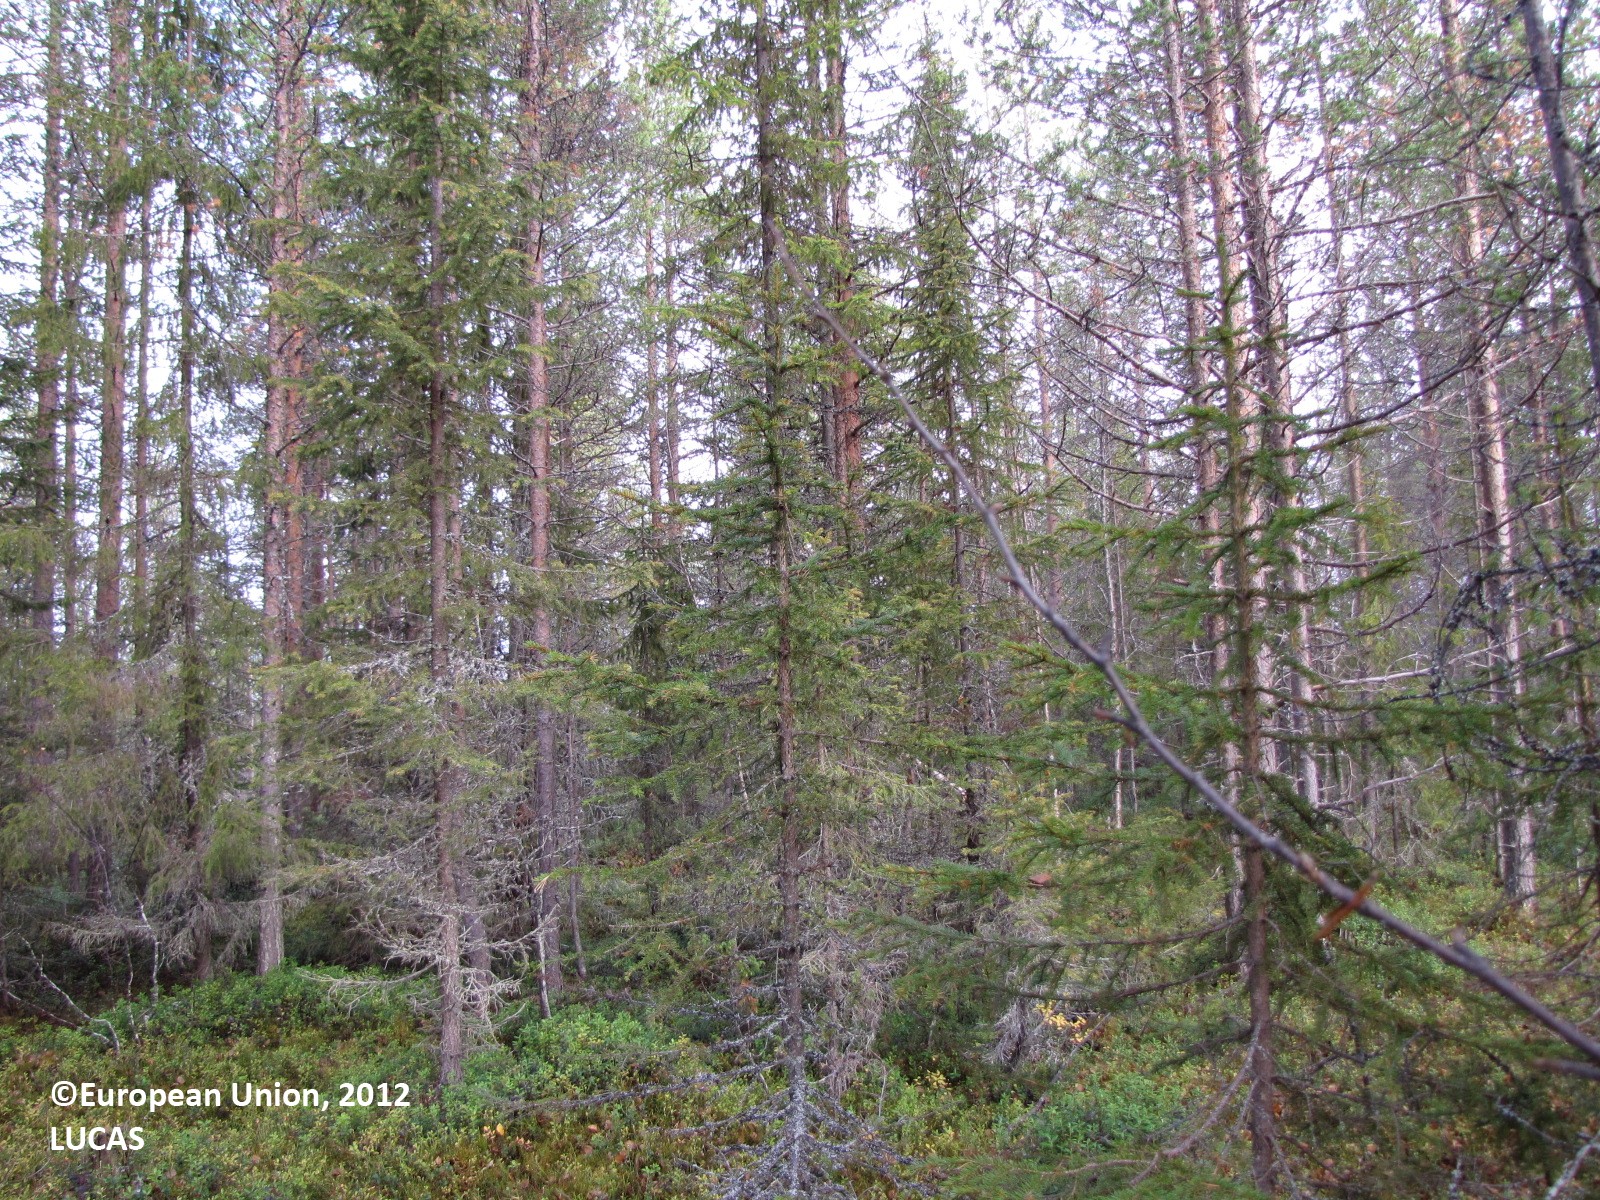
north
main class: Woodland
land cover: Pine dominated coniferous woodland
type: boreal forest
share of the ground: 25 - 50 %
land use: Forestry
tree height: > 5 m
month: September
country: FI
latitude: 67.7322
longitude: 25.1978
